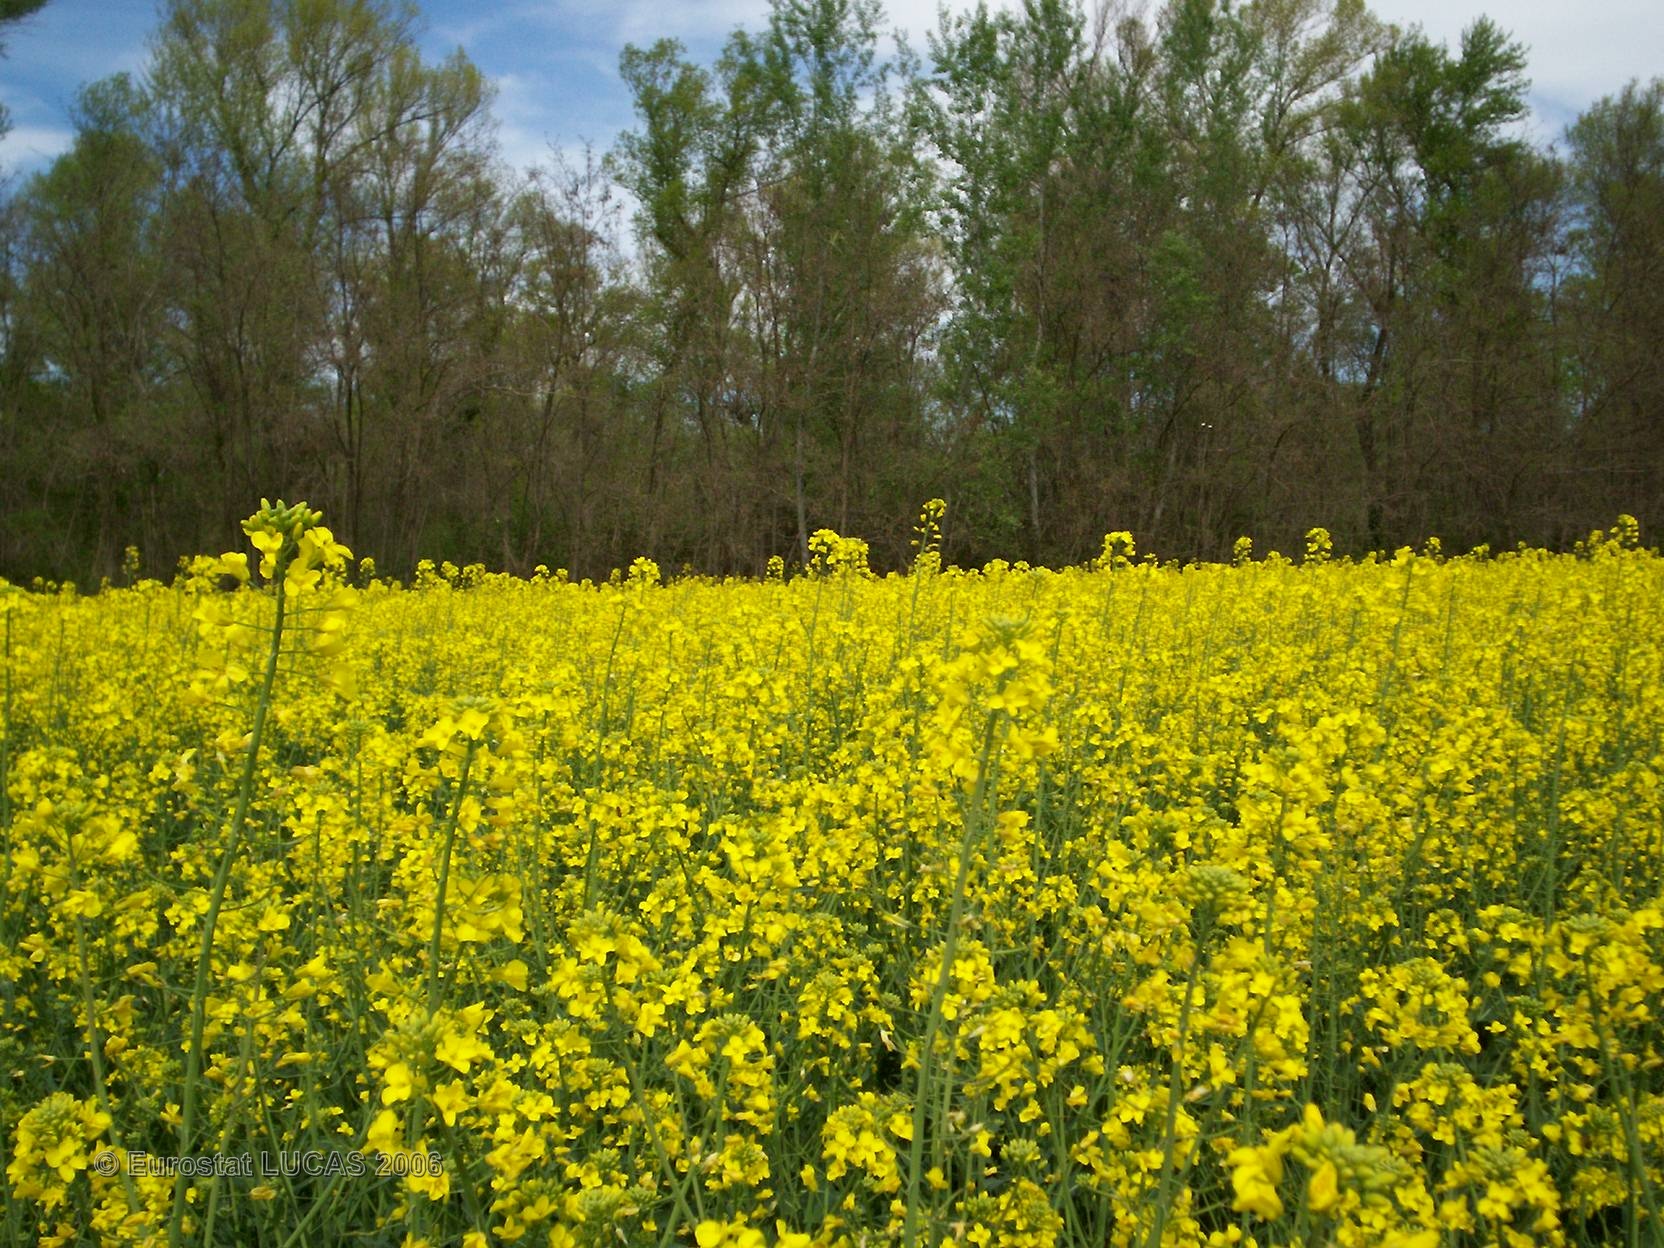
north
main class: Cropland
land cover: Rape and turnip rape
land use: Agriculture (excluding fallow land and kitchen gardens)
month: April
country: FR
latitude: 43.7372
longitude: 5.2786
